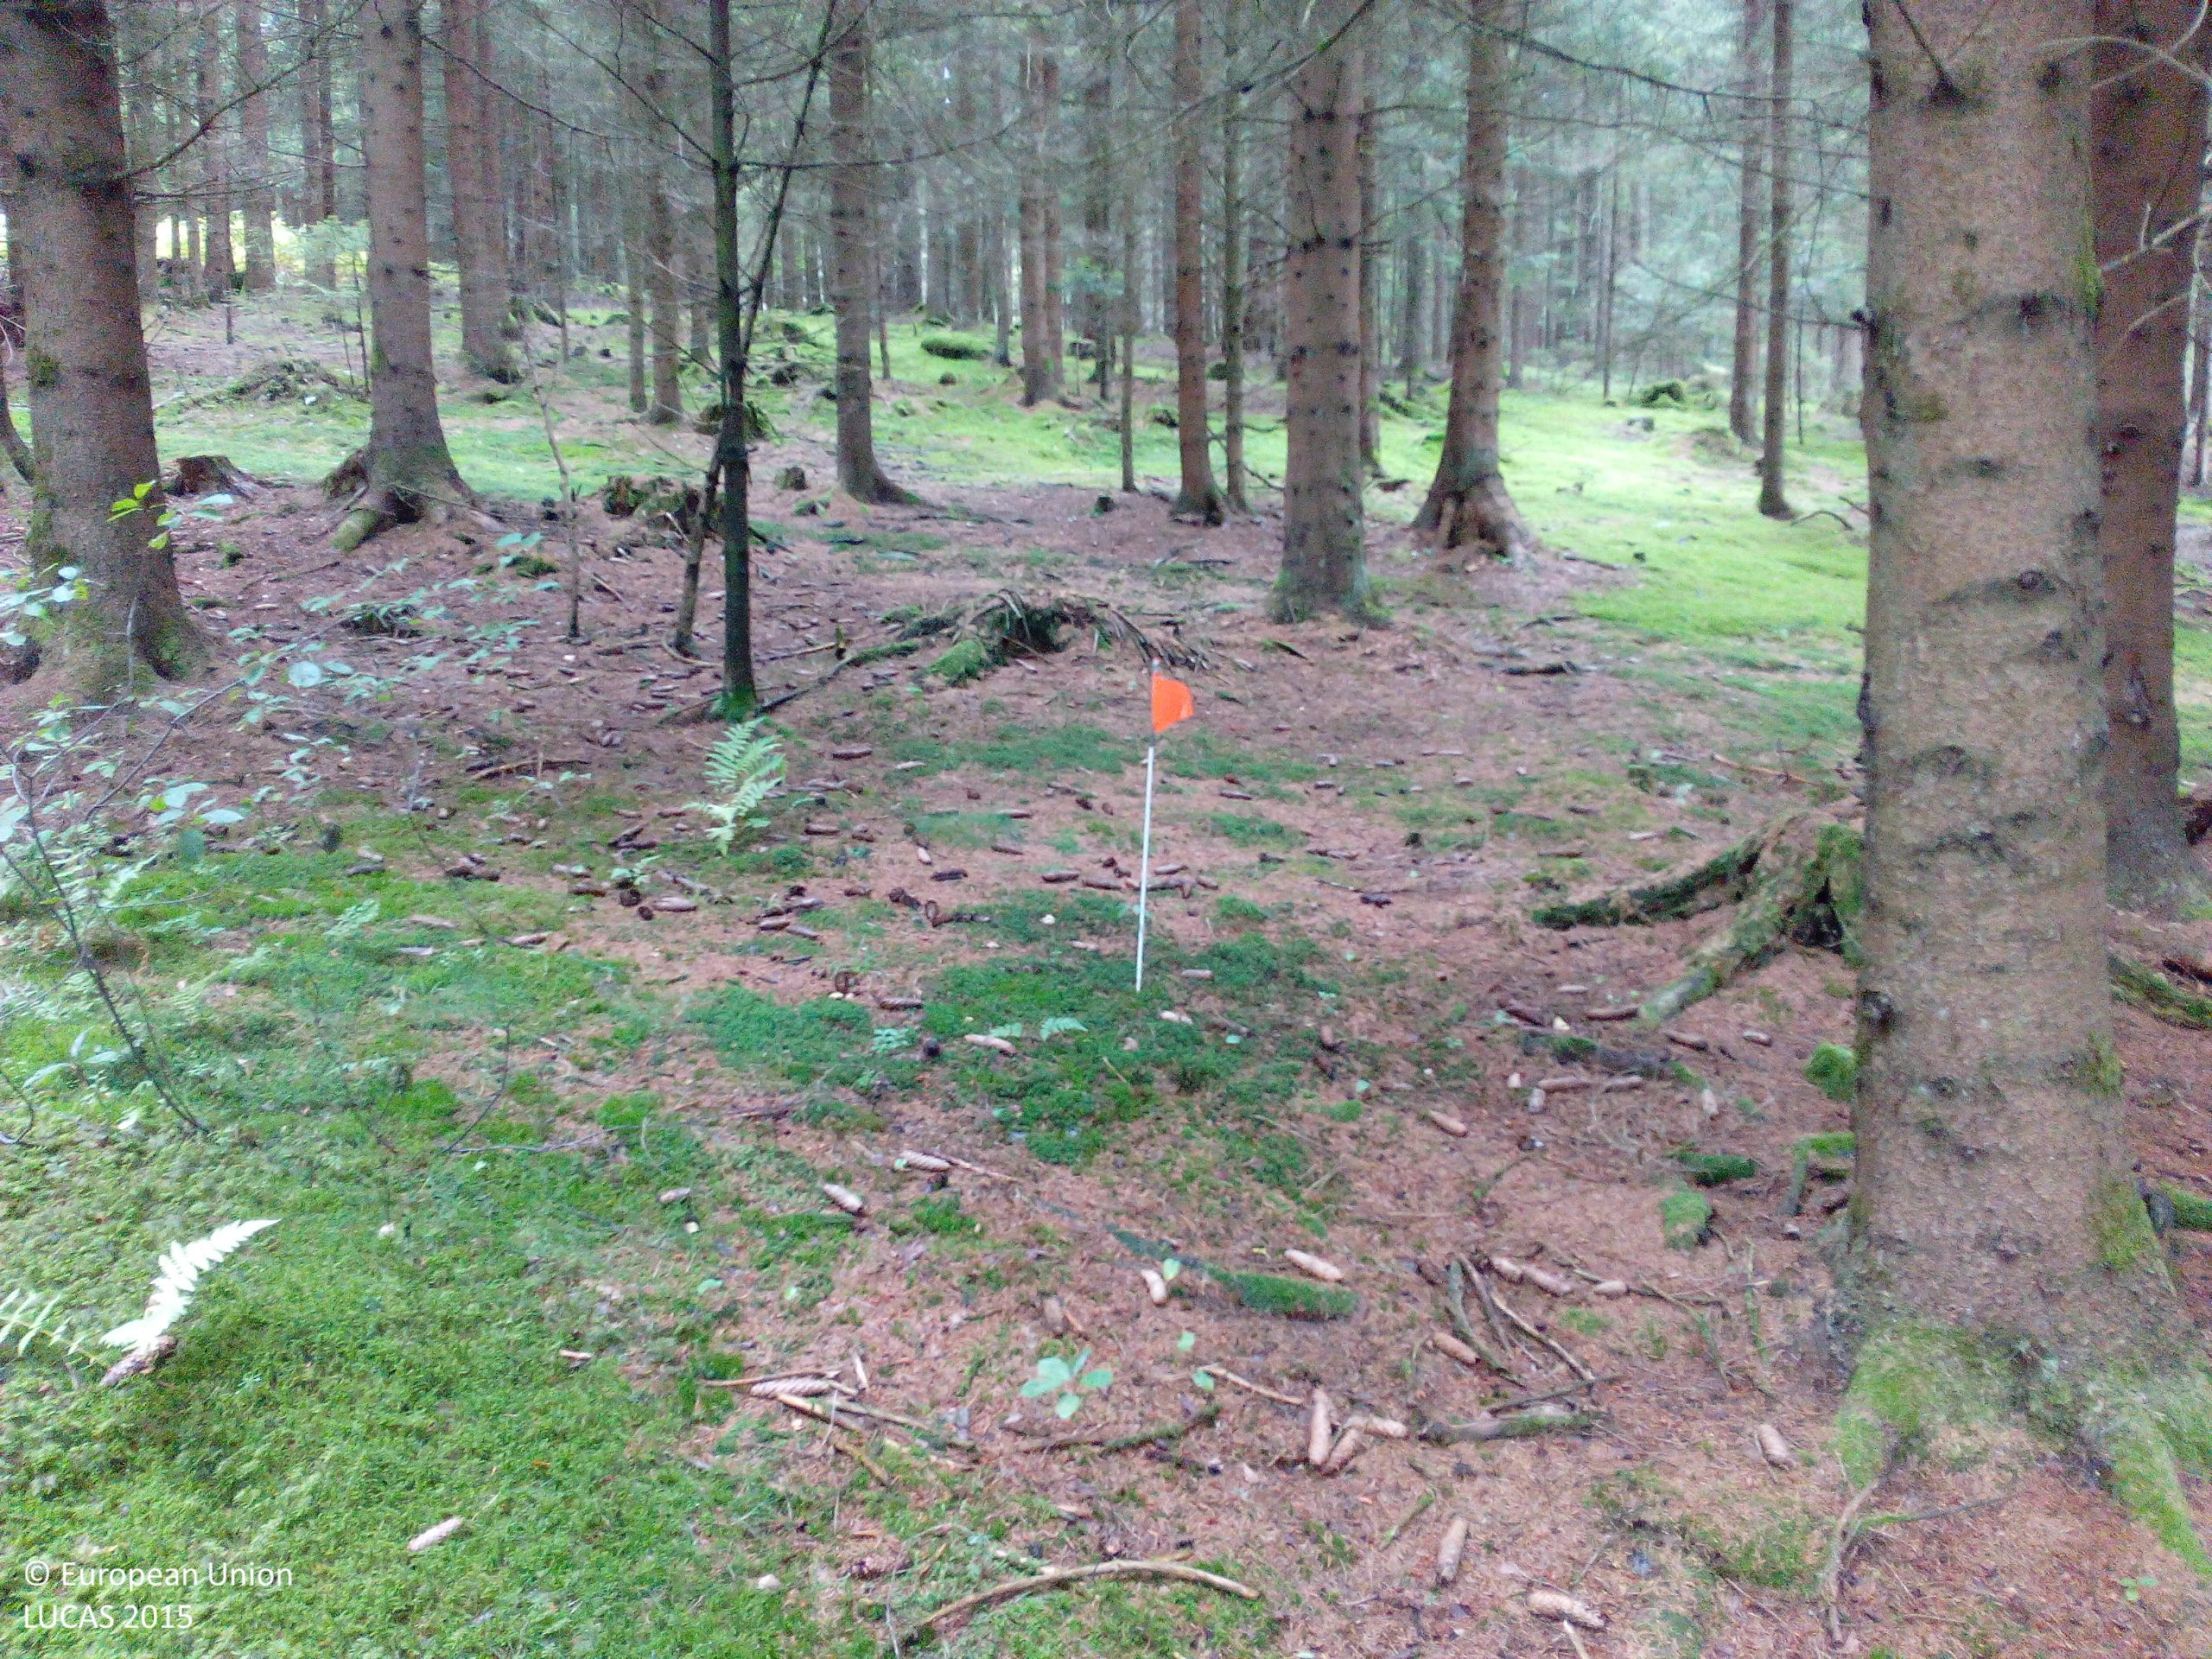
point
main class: Woodland
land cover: Spruce dominated coniferous woodland
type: hemiboreal forest and nemoral coniferous forest and mixed broadleaved-coniferous forest
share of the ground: > 75 %
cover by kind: coniferous forest trees 90 %, unconsolidated bare surface 10 %
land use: Forestry
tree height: > 5 m
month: September
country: DE
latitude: 48.9400
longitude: 12.9621
